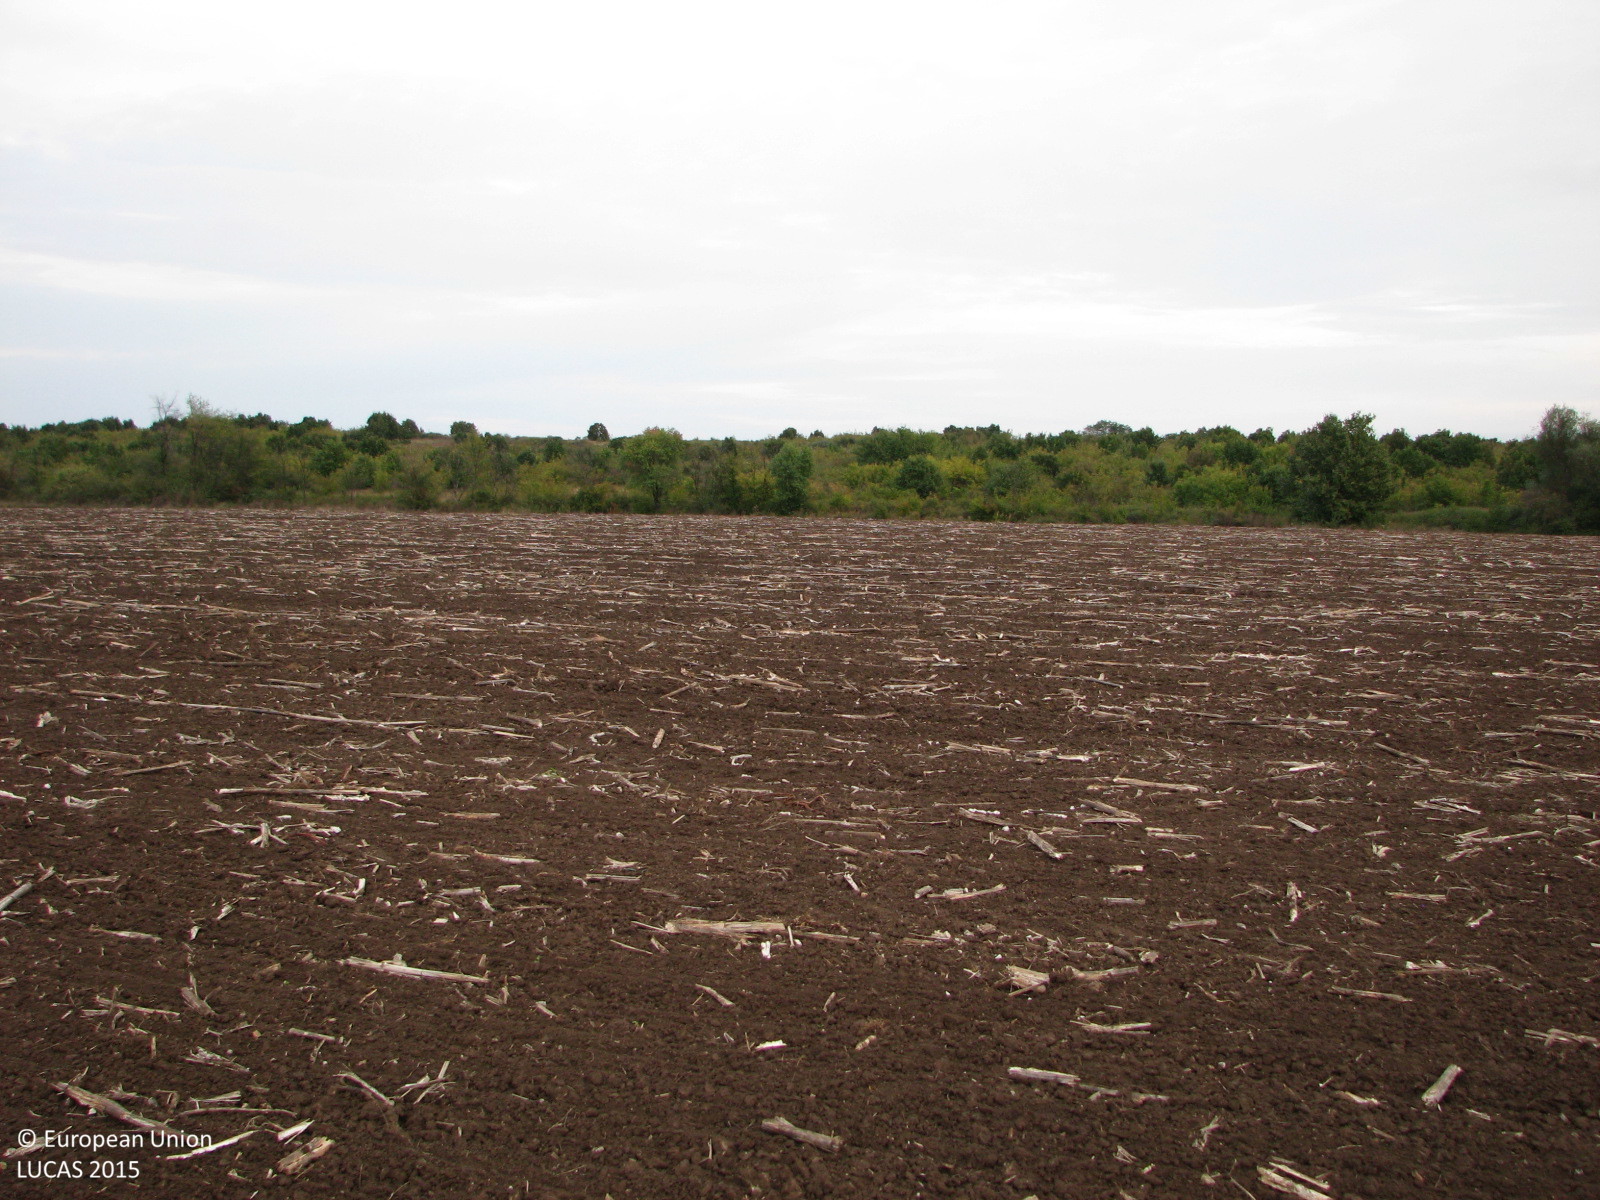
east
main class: Cropland
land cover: Sunflower
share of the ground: < 10 %
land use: Agriculture (excluding fallow land and kitchen gardens)
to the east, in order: Sunflower; Tracks; Shrubland with sparse tree cover
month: October
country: BG
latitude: 42.3909
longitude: 26.1788
